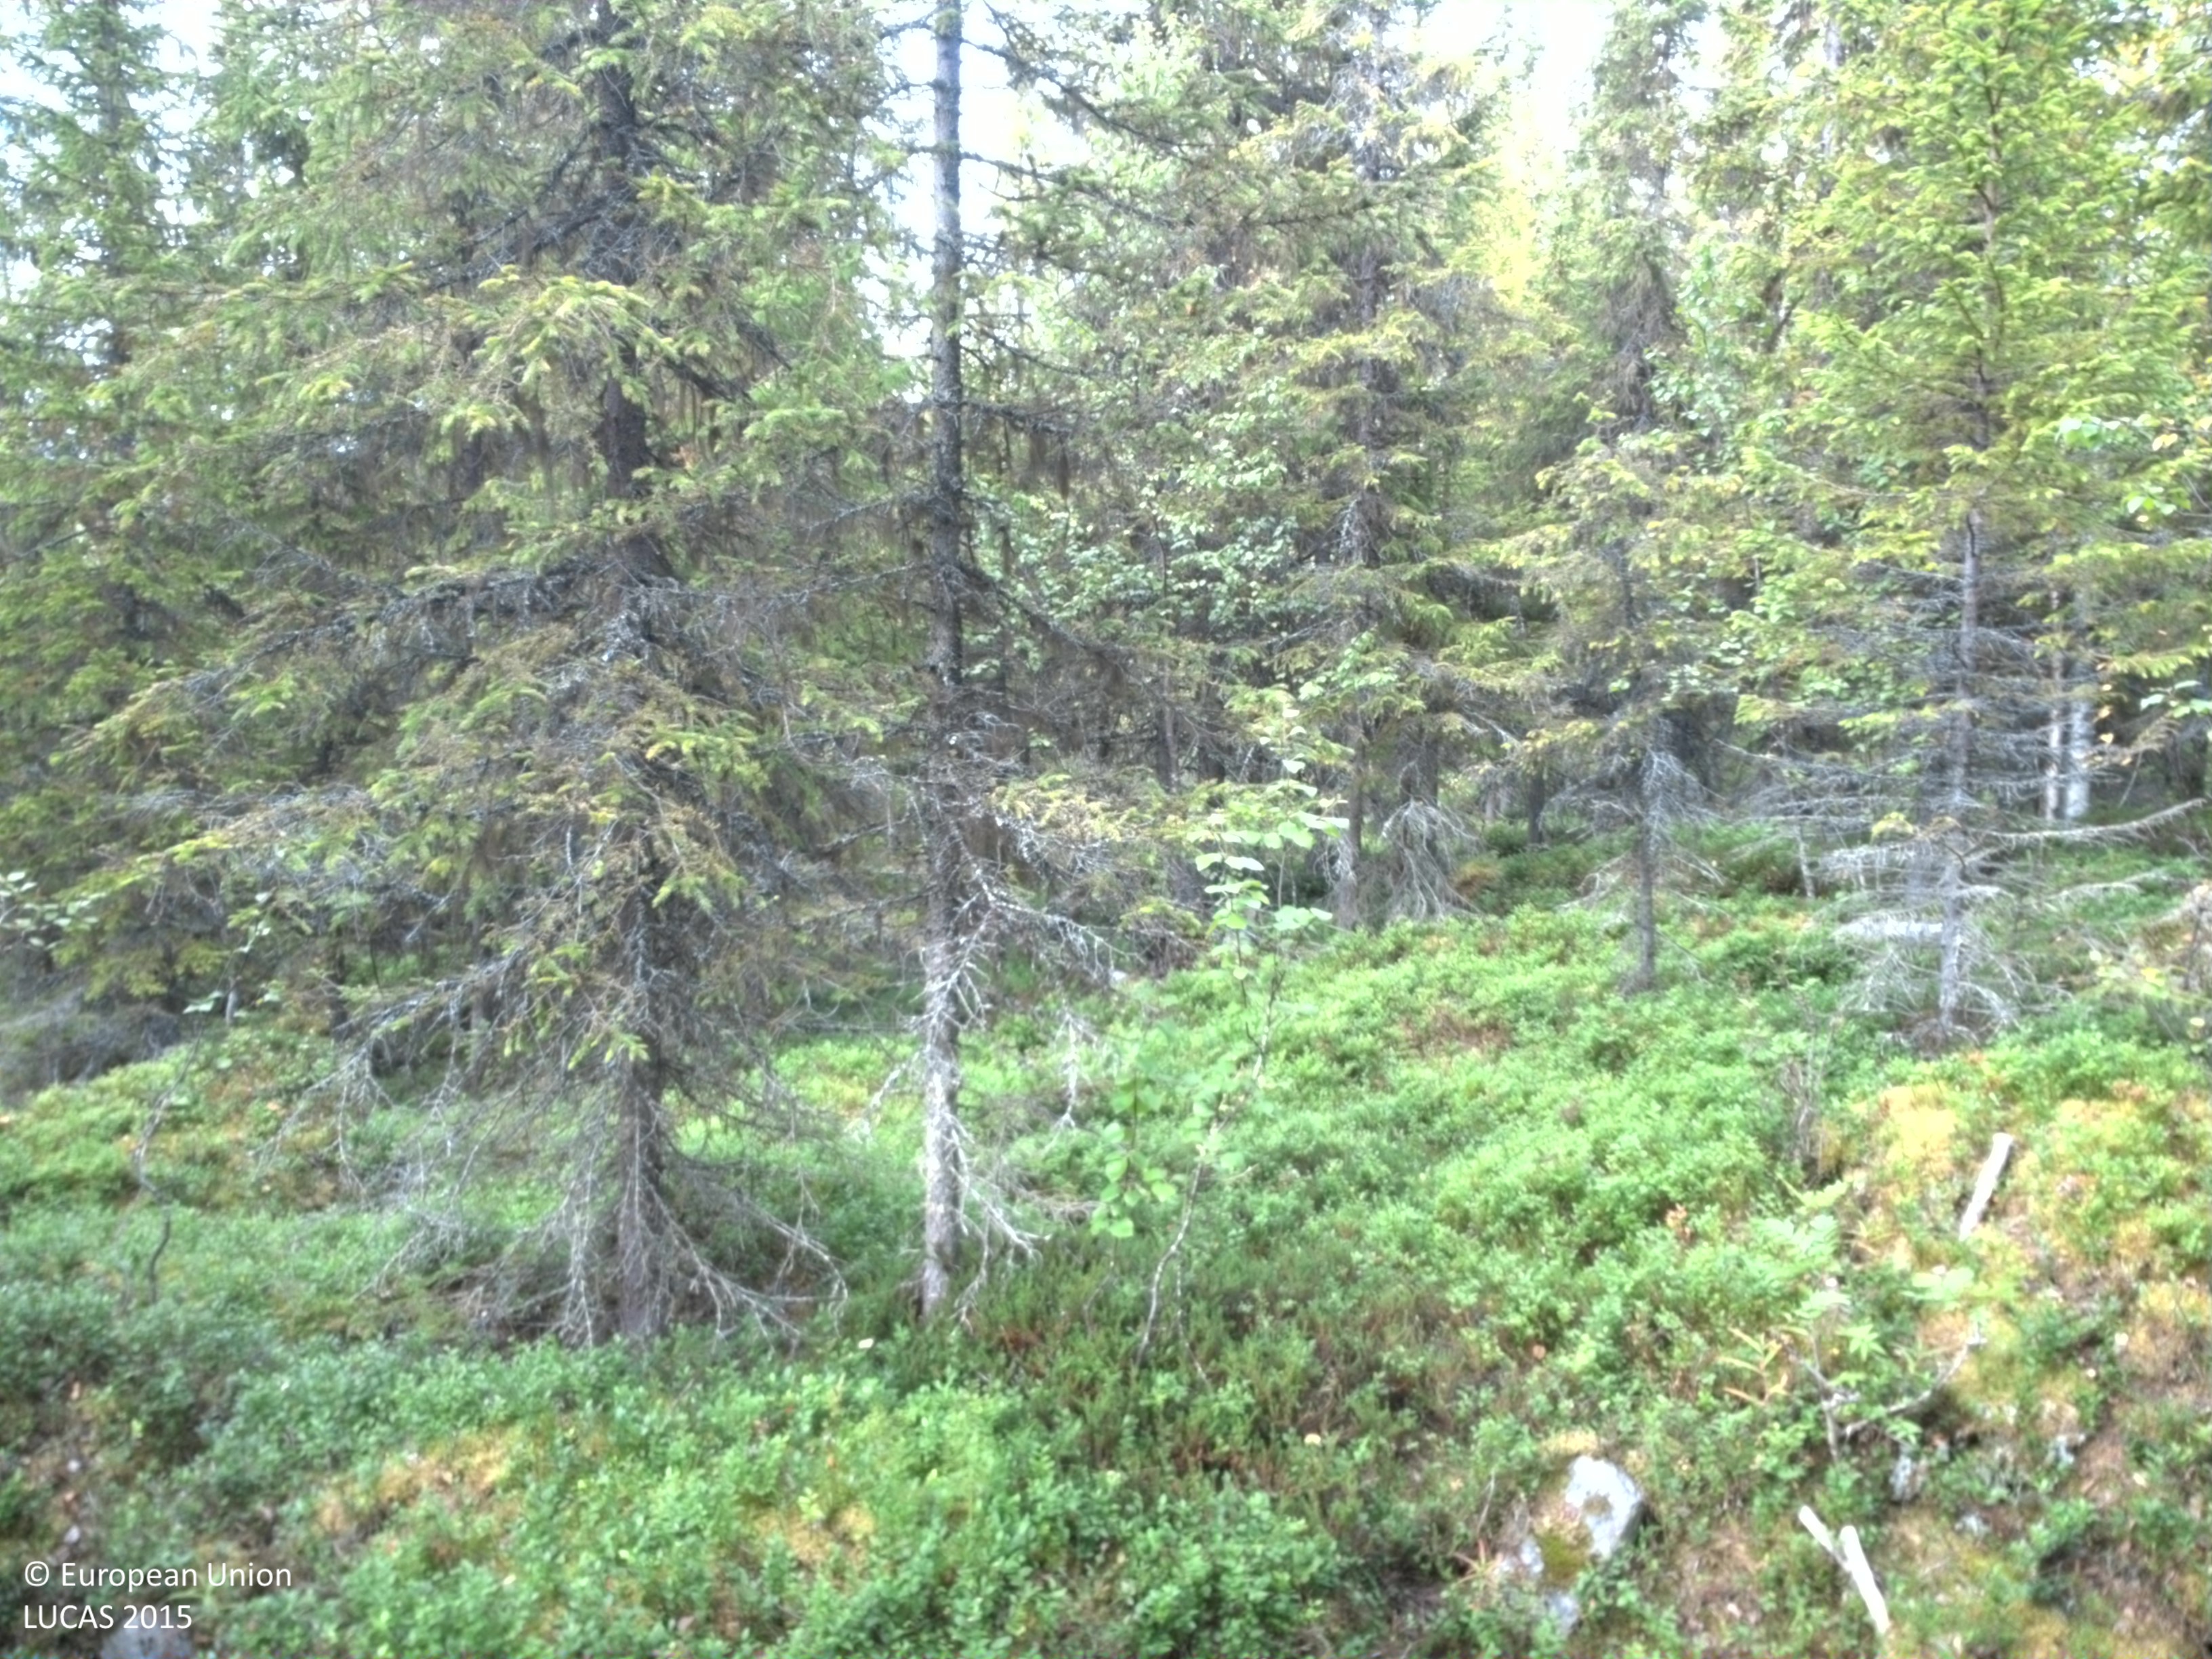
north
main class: Woodland
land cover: Spruce dominated mixed woodland
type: boreal forest
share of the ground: 25 - 50 %
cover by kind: coniferous forest trees 30 %, shrubs 30 %, broadleaved forest trees 20 %, lichens and mosses 15 %, herbaceous plants 5 %
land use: Forestry
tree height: > 5 m
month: September
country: SE
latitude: 65.3475
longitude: 16.1728
